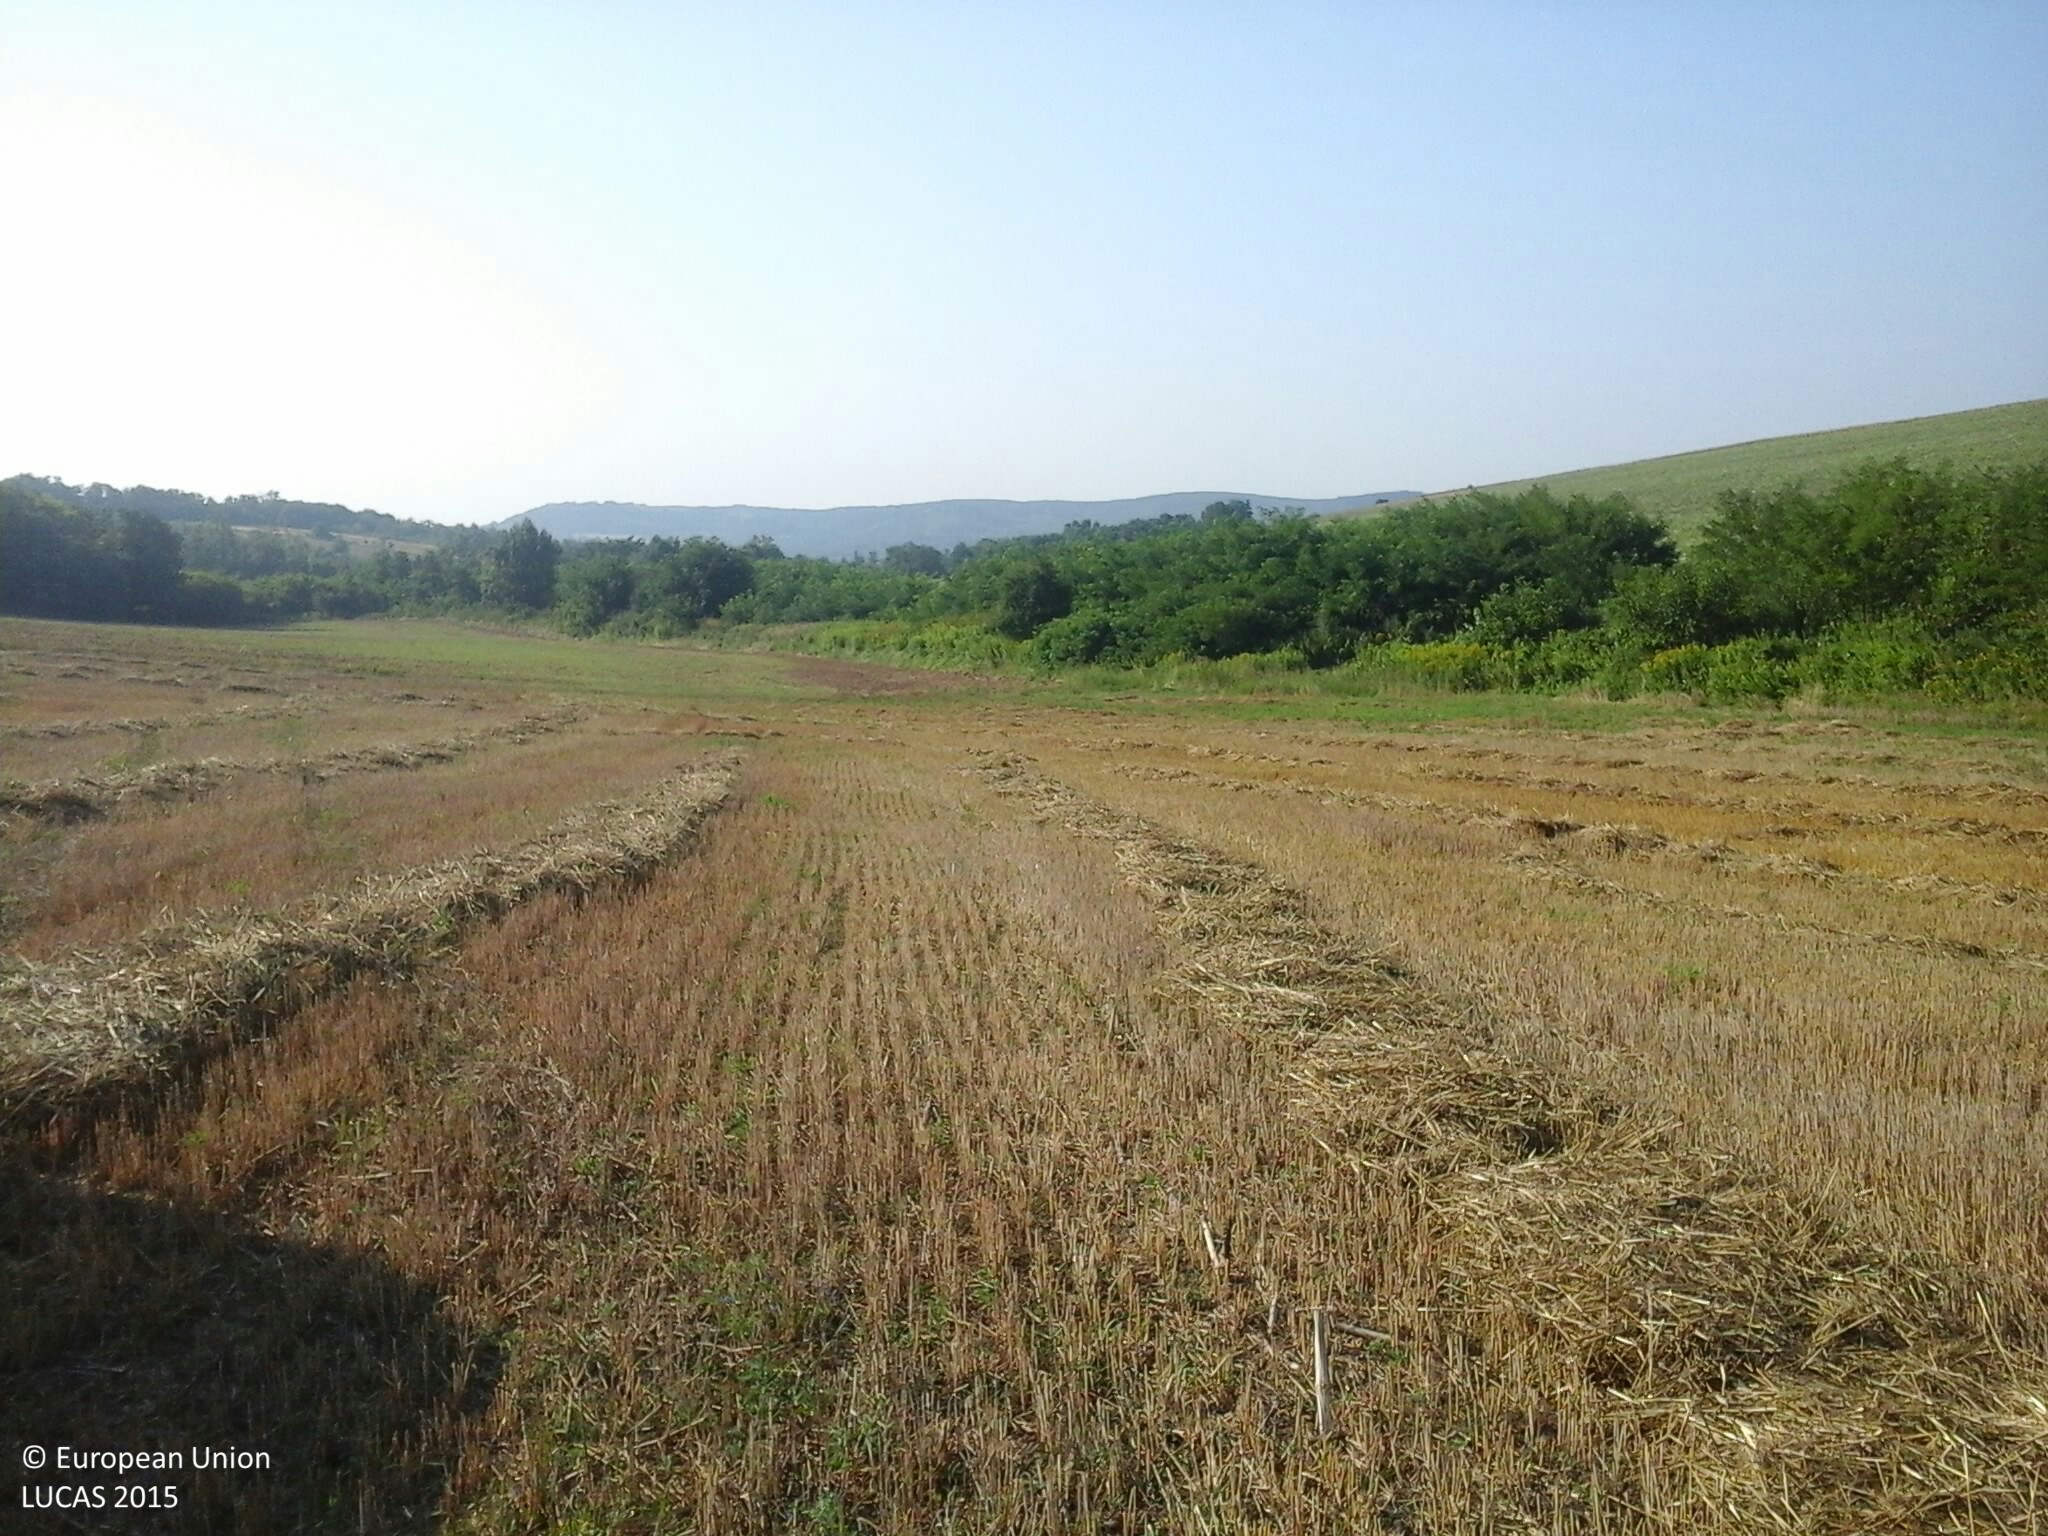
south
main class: Cropland
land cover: Durum wheat
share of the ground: > 75 %
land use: Agriculture (excluding fallow land and kitchen gardens)
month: August
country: HU
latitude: 46.7684
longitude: 18.0883
